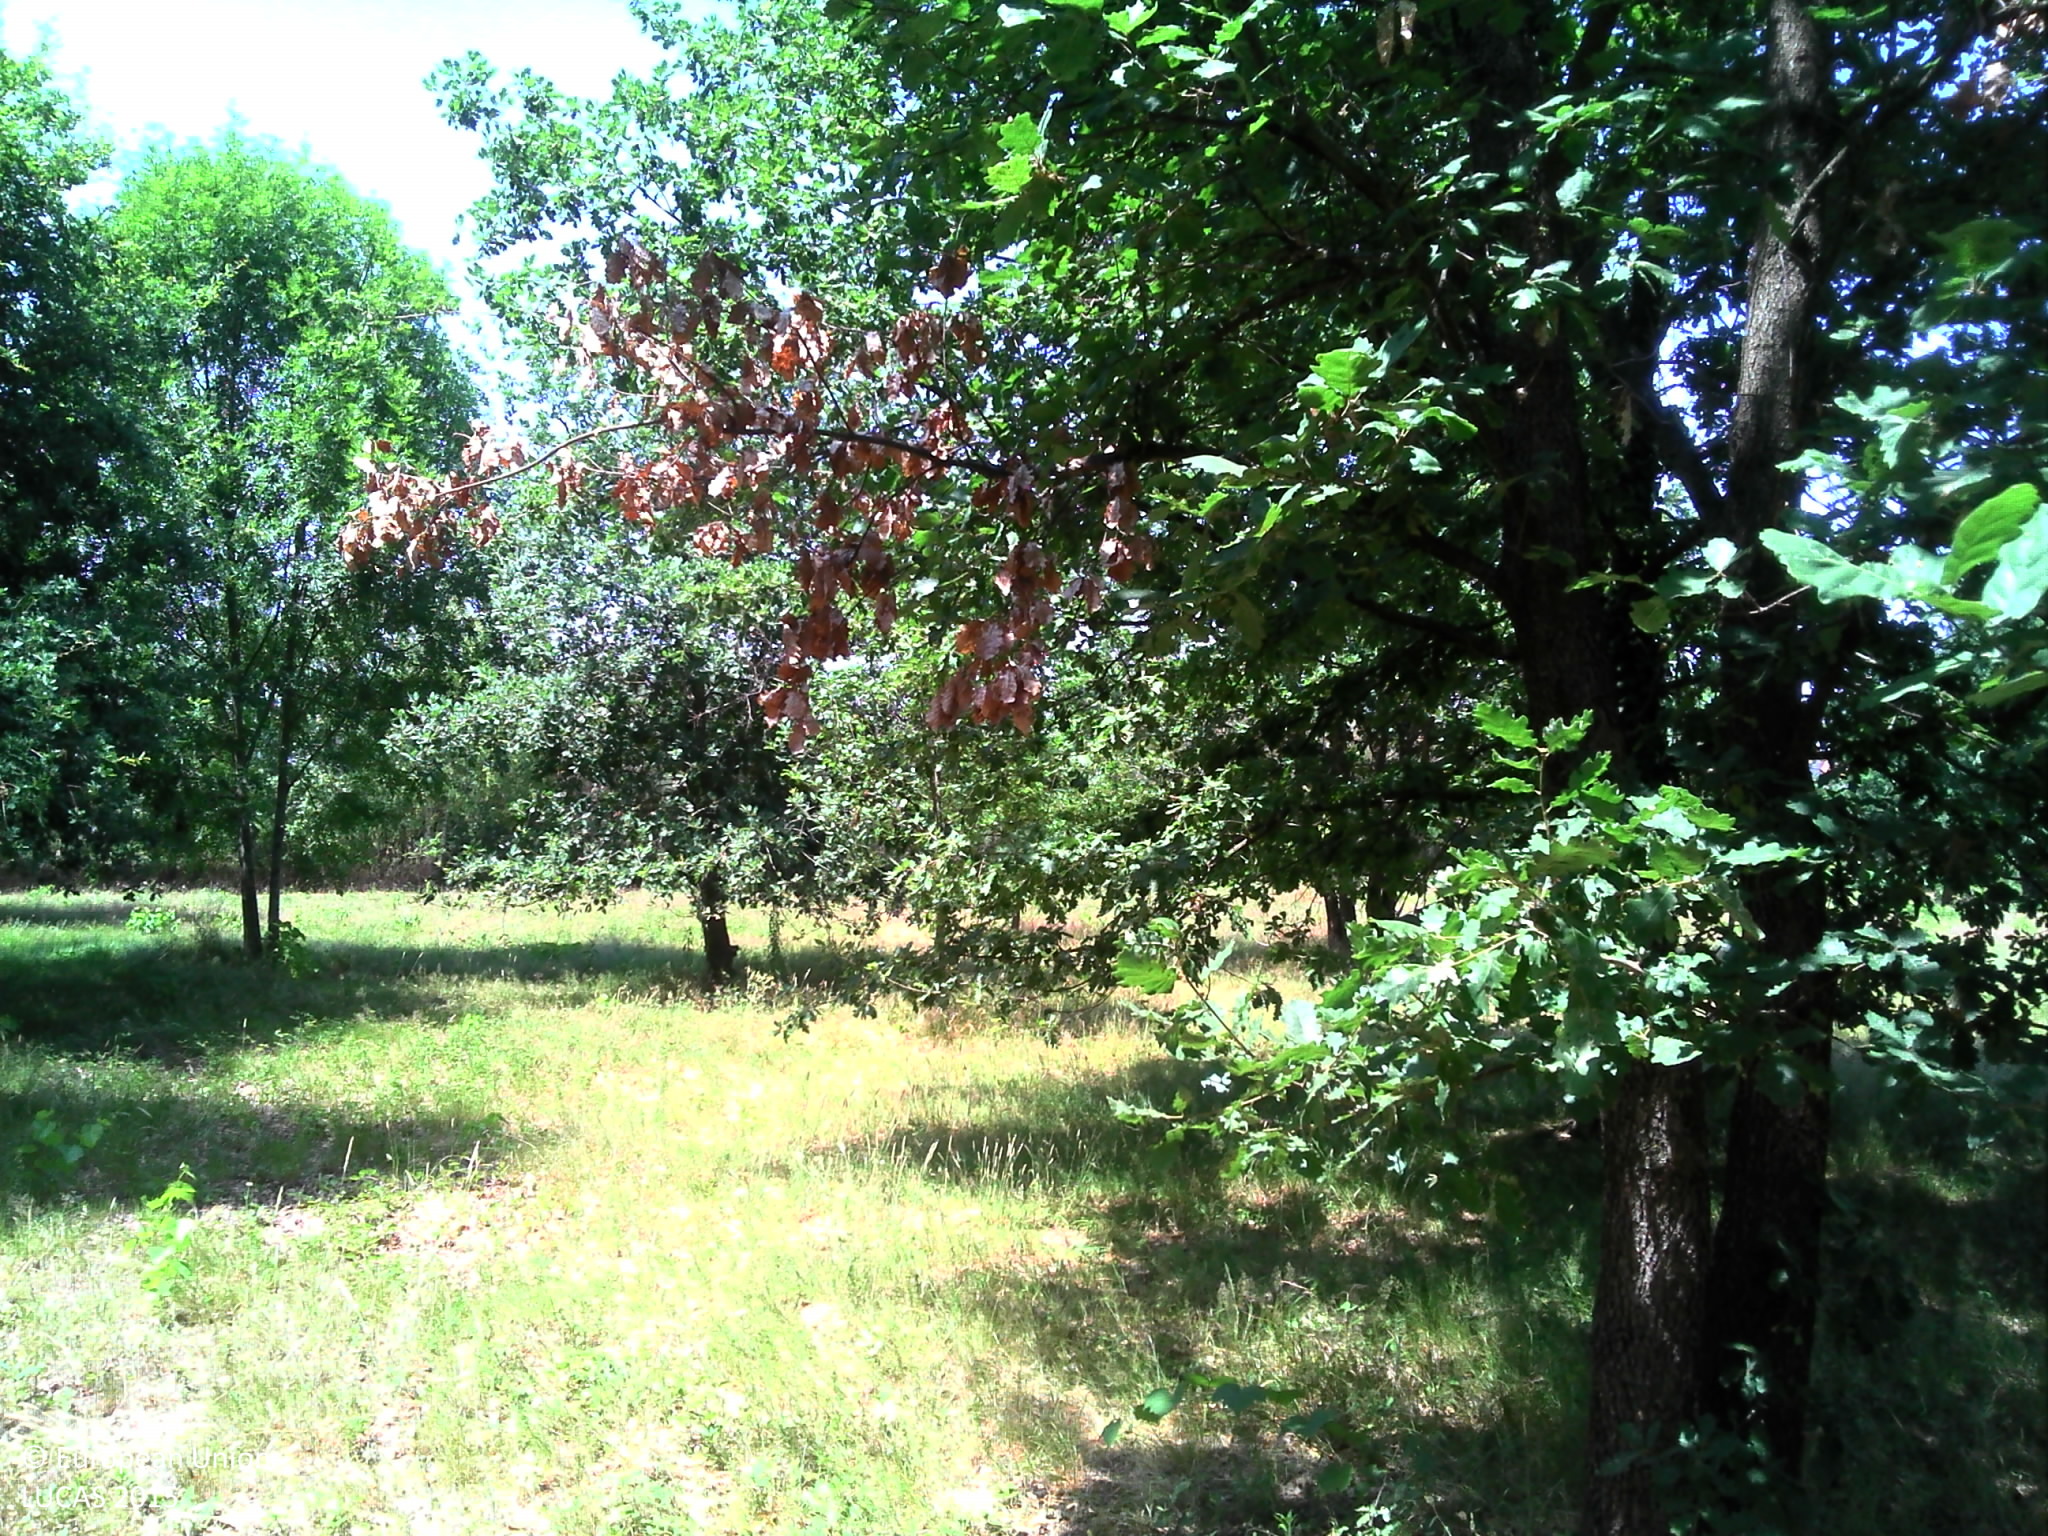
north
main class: Grassland
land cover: Grassland with sparse tree/shrub cover
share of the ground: > 75 %
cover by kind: herbaceous plants 95 %, broadleaved forest trees 5 %
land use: Agriculture (excluding fallow land and kitchen gardens)
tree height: < 5 m
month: July
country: FR
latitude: 43.0523
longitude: 1.6458
